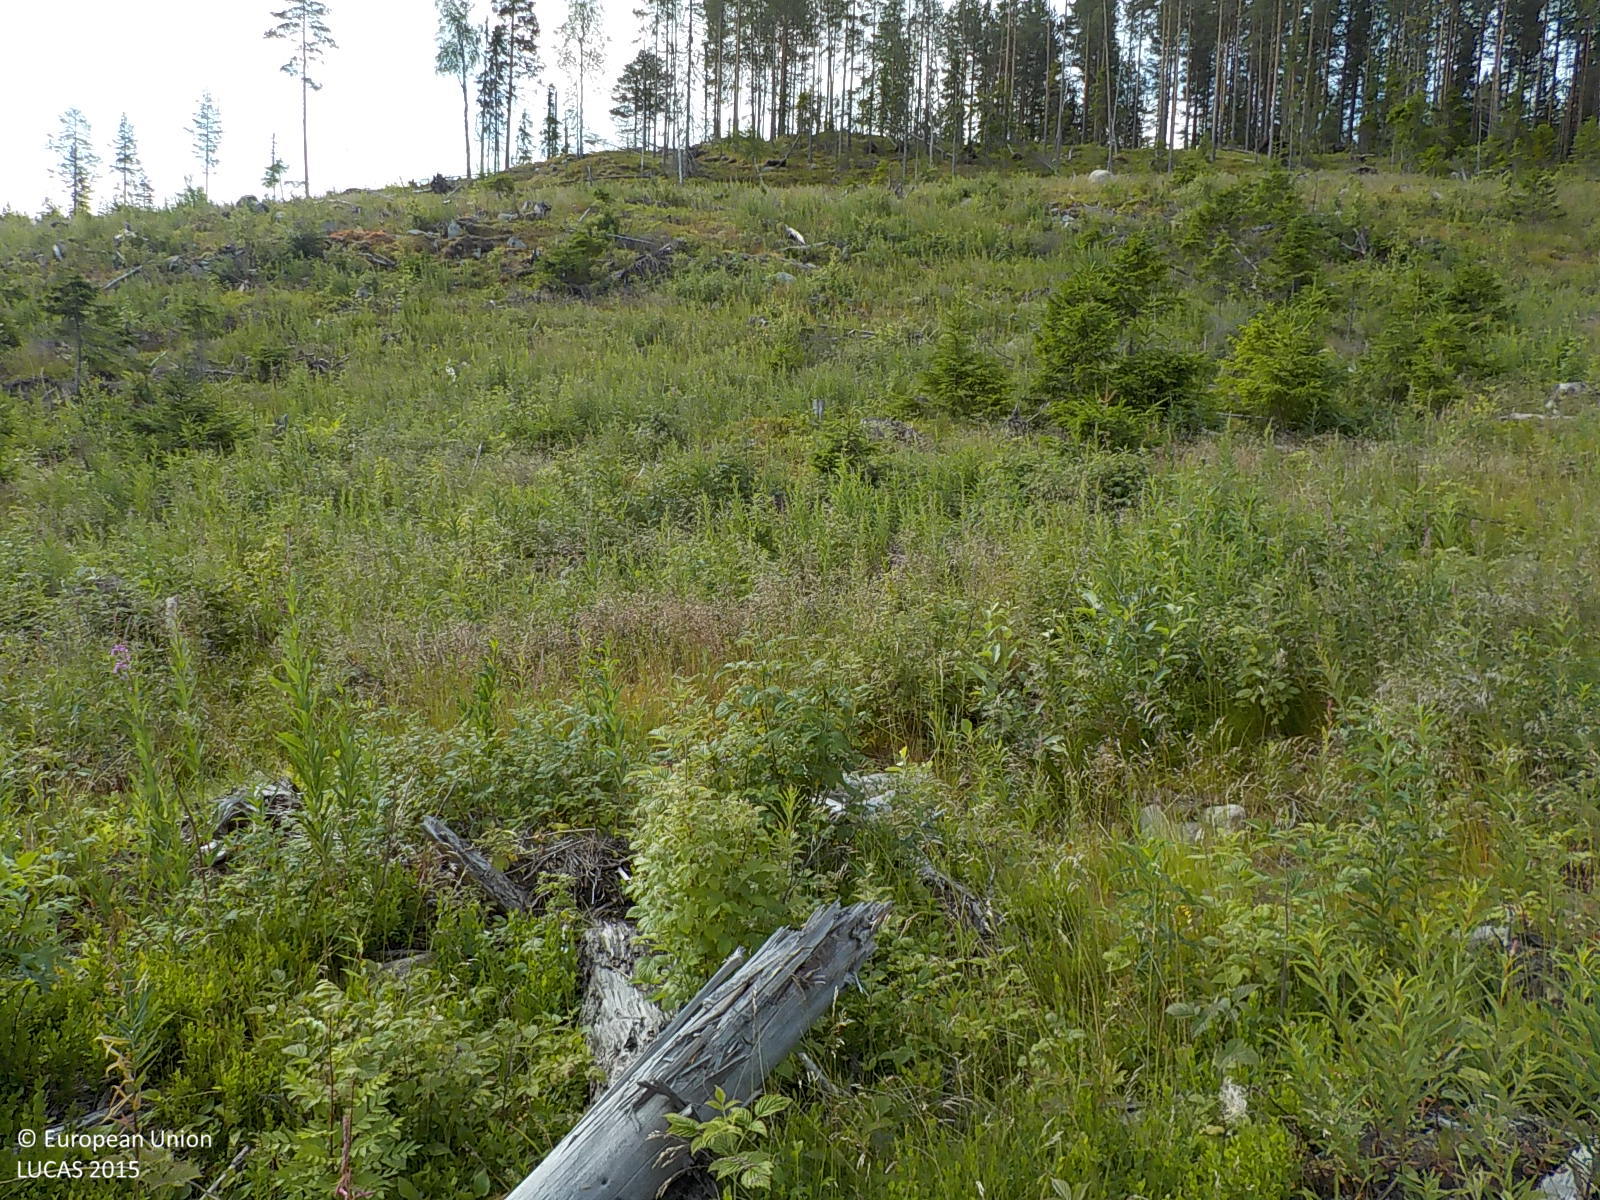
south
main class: Woodland
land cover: Other mixed woodland
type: boreal forest
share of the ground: 25 - 50 %
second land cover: Grassland without tree/shrub cover
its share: 25 - 50 %
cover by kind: herbaceous plants 35 %, coniferous forest trees 30 %, broadleaved forest trees 30 %, shrubs 5 %
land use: Forestry
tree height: < 5 m
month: July
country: SE
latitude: 63.2015
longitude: 17.1923
